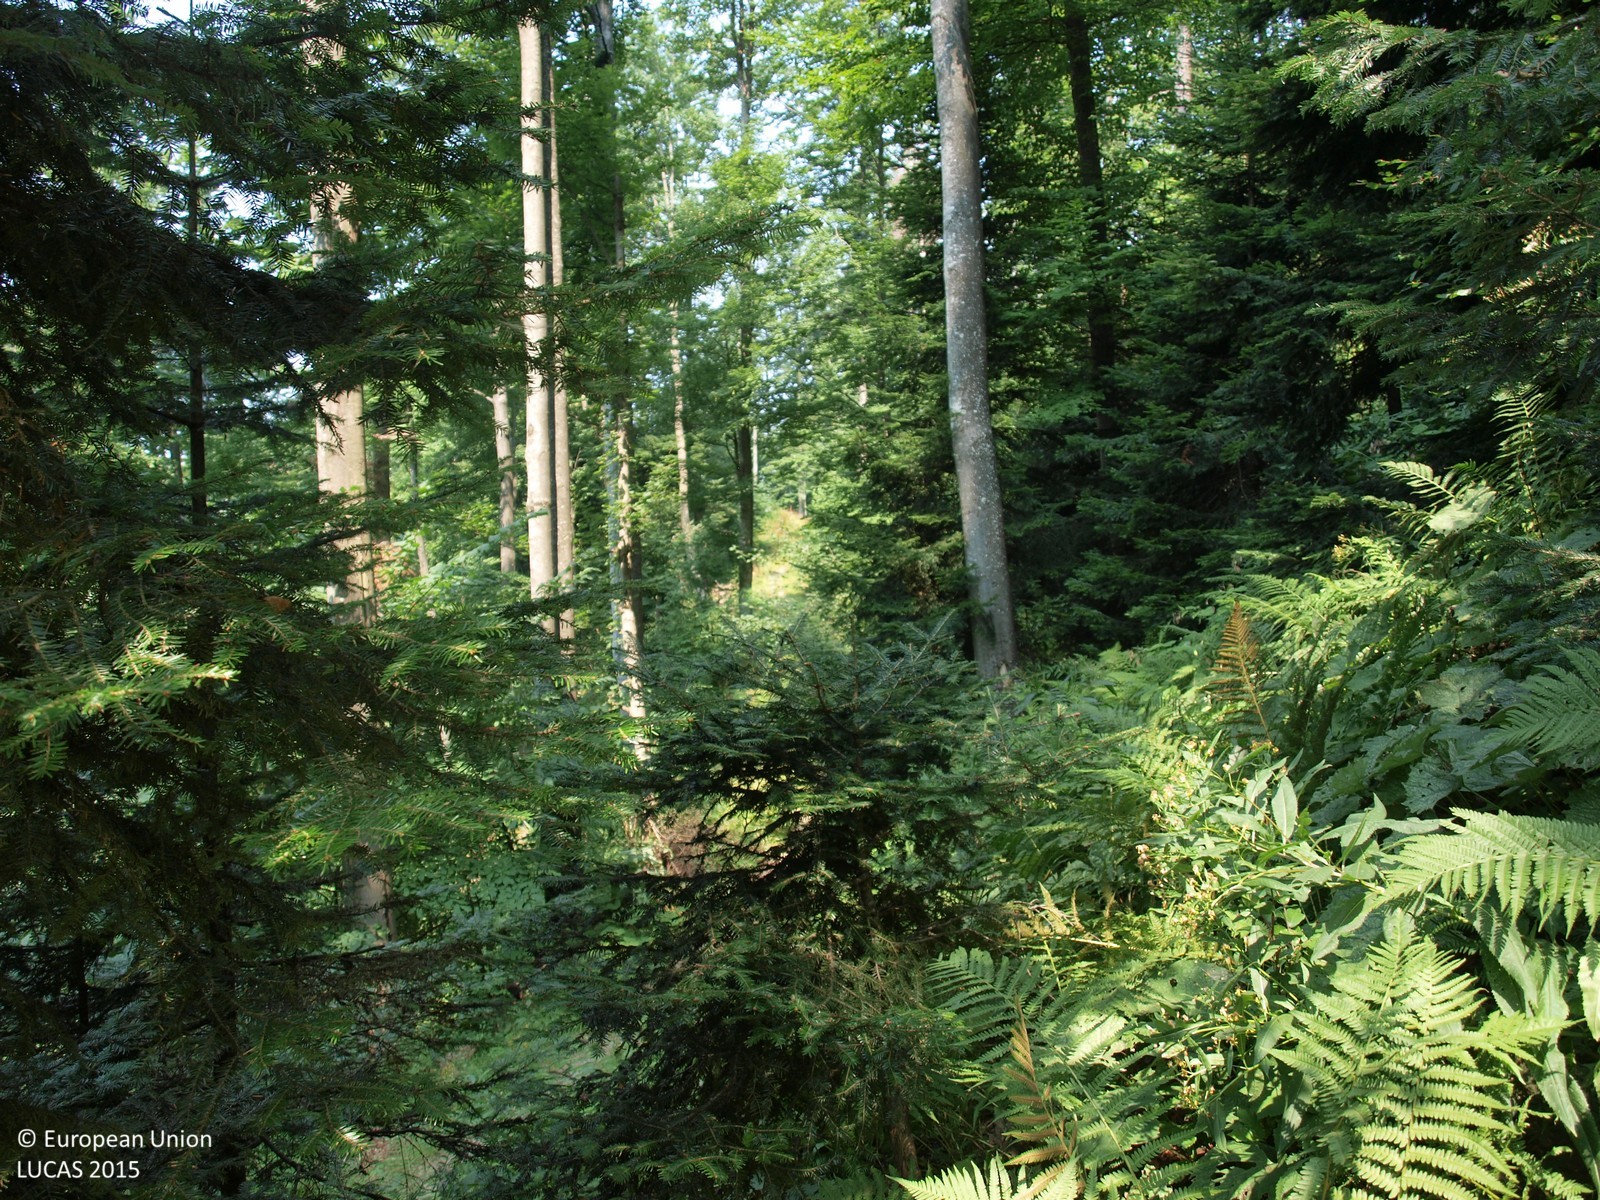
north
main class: Woodland
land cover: Broadleaved woodland
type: beech forest
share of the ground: > 75 %
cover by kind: broadleaved forest trees 65 %, coniferous forest trees 15 %, shrubs 10 %, herbaceous plants 10 %
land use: Forestry
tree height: > 5 m
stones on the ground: < 10 %
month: August
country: HR
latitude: 45.8972
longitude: 15.9397
